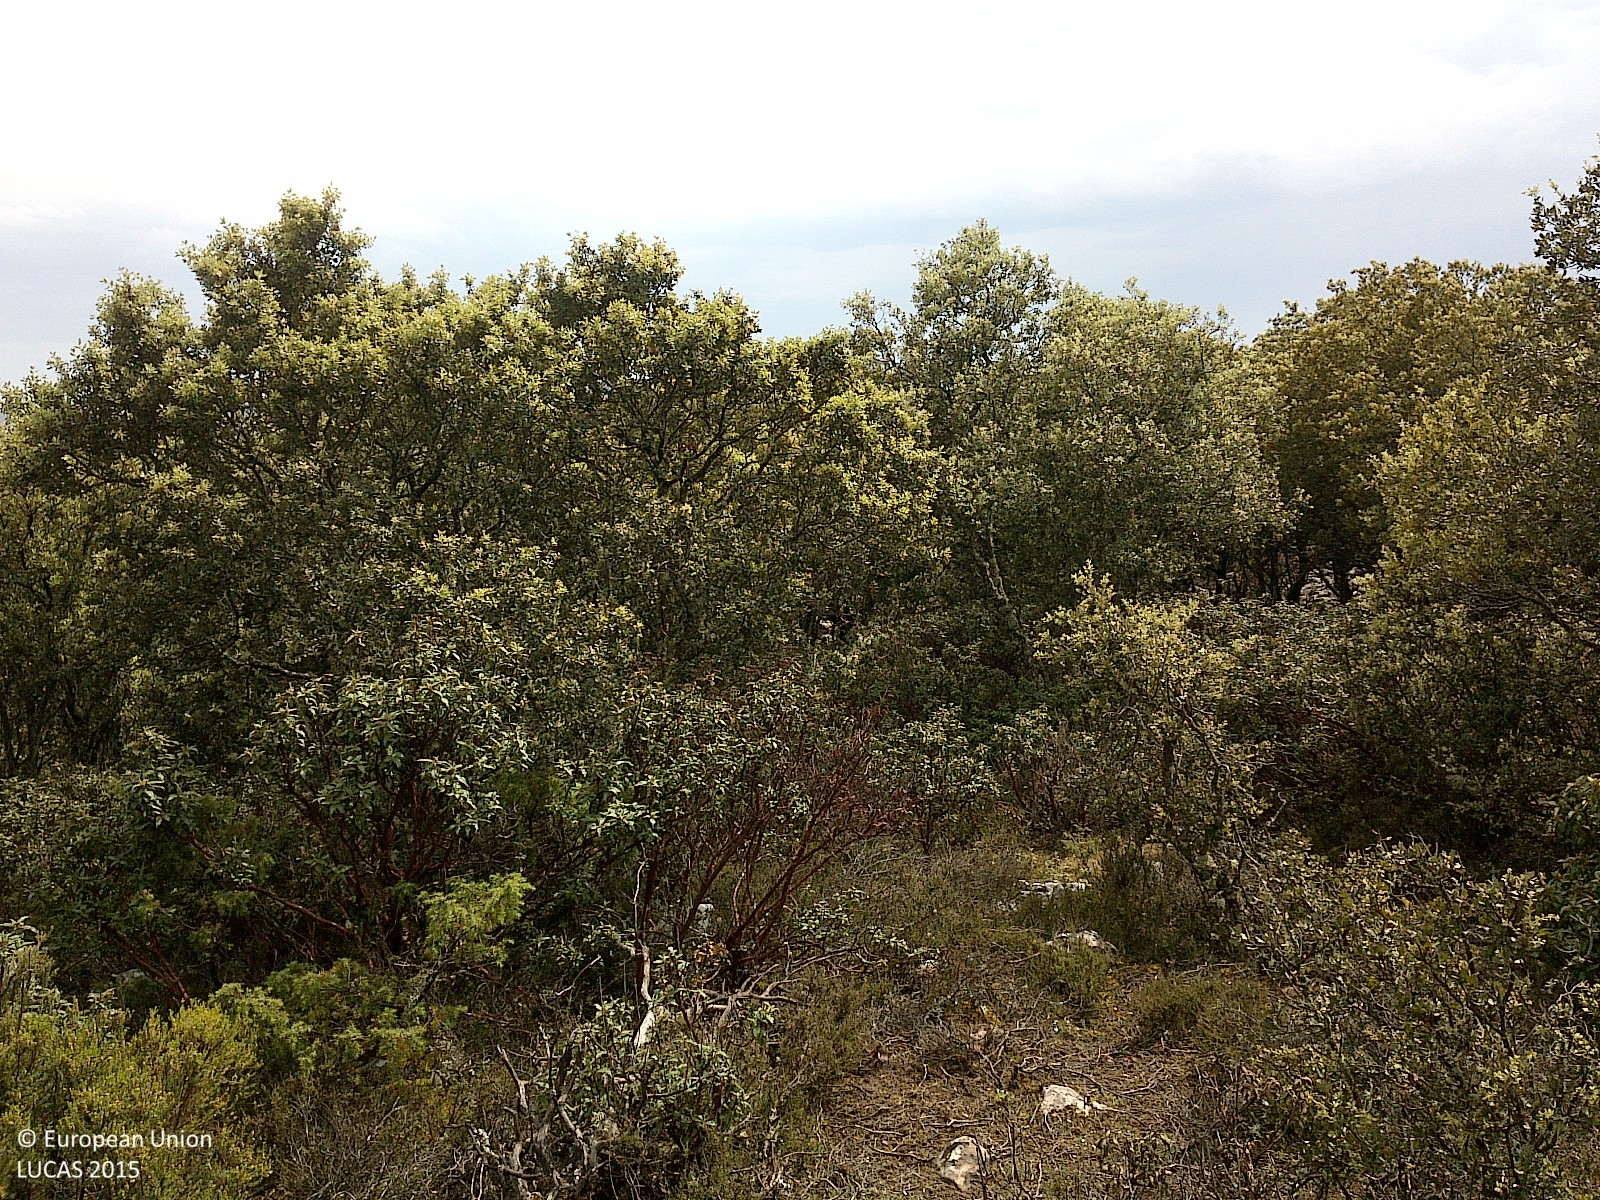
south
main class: Woodland
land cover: Broadleaved woodland
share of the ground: > 75 %
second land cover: Shrubland without tree cover
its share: 50 - 75 %
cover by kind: broadleaved forest trees 75 %, shrubs 15 %, herbaceous plants 5 %, consolidated bare surface 5 %
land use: Forestry
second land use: Agriculture (excluding fallow land and kitchen gardens)
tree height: < 5 m
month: May
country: ES
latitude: 41.8156
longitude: -2.2548
